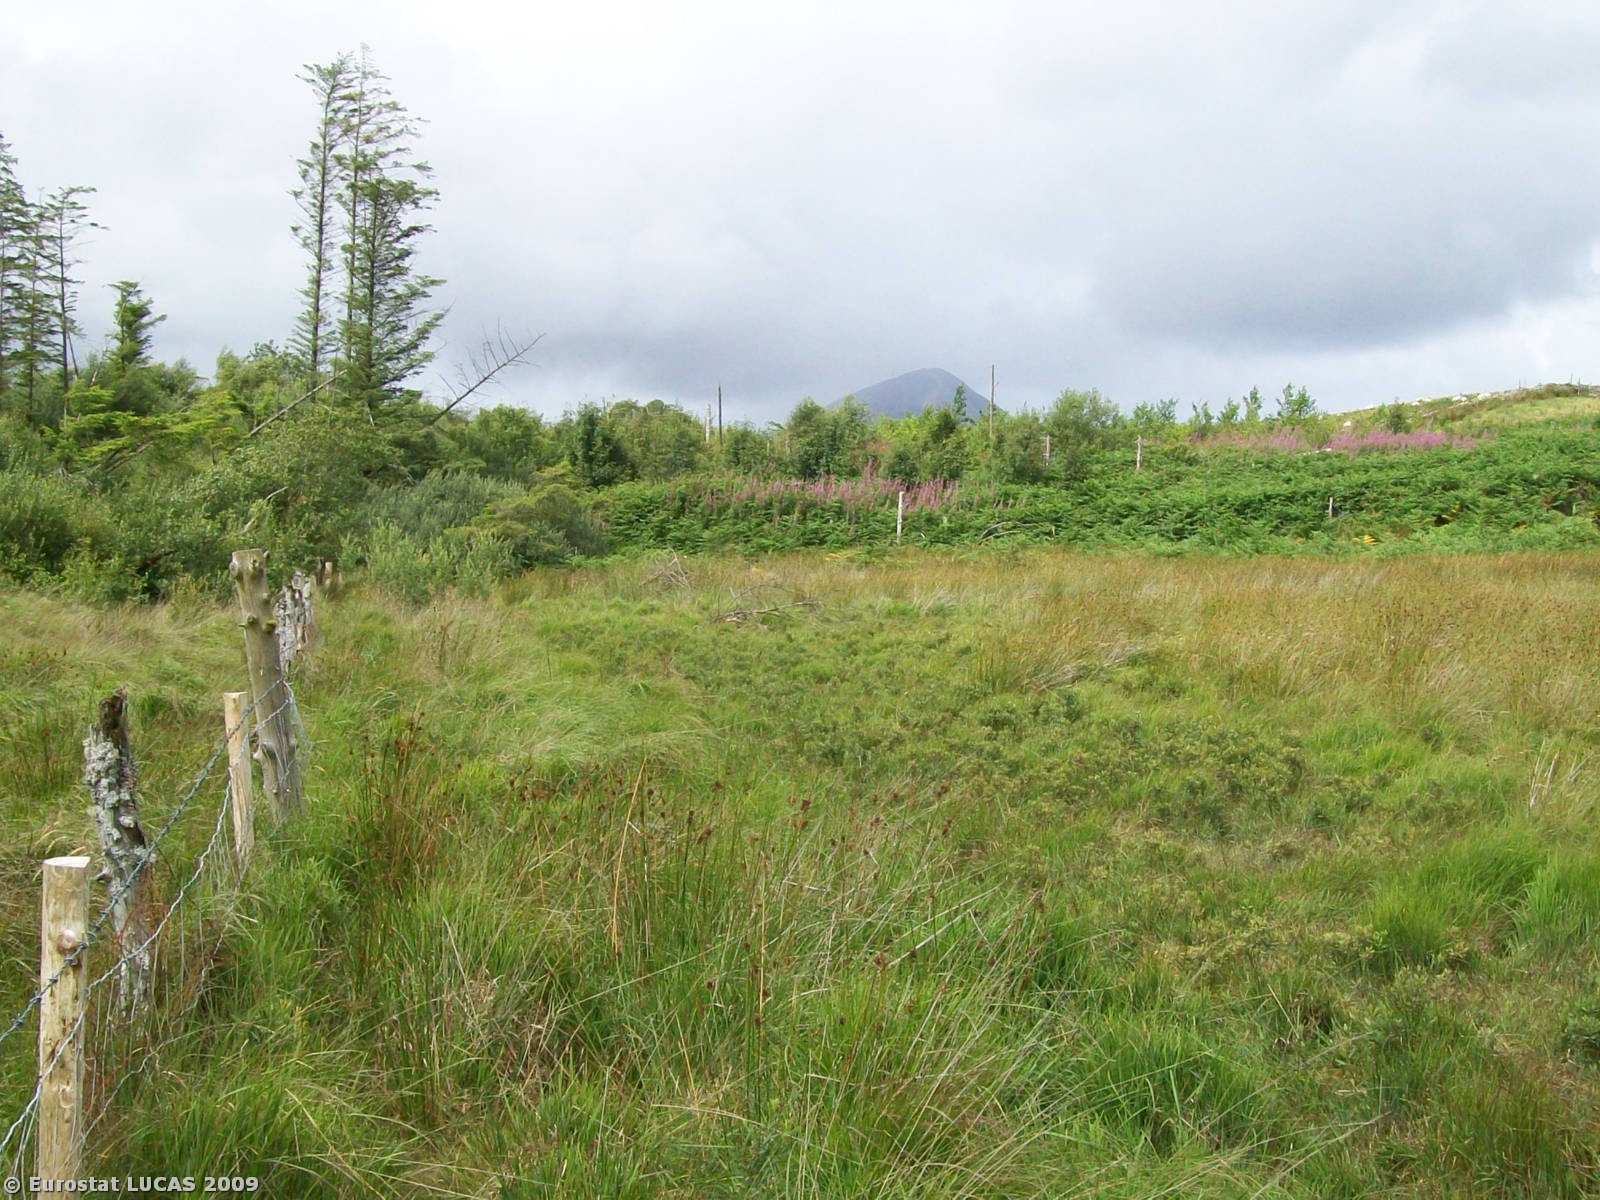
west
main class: Woodland
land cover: Mixed woodland
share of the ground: > 75 %
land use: Forestry
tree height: < 5 m
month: July
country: IE
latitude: 53.7299
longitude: -9.5607
